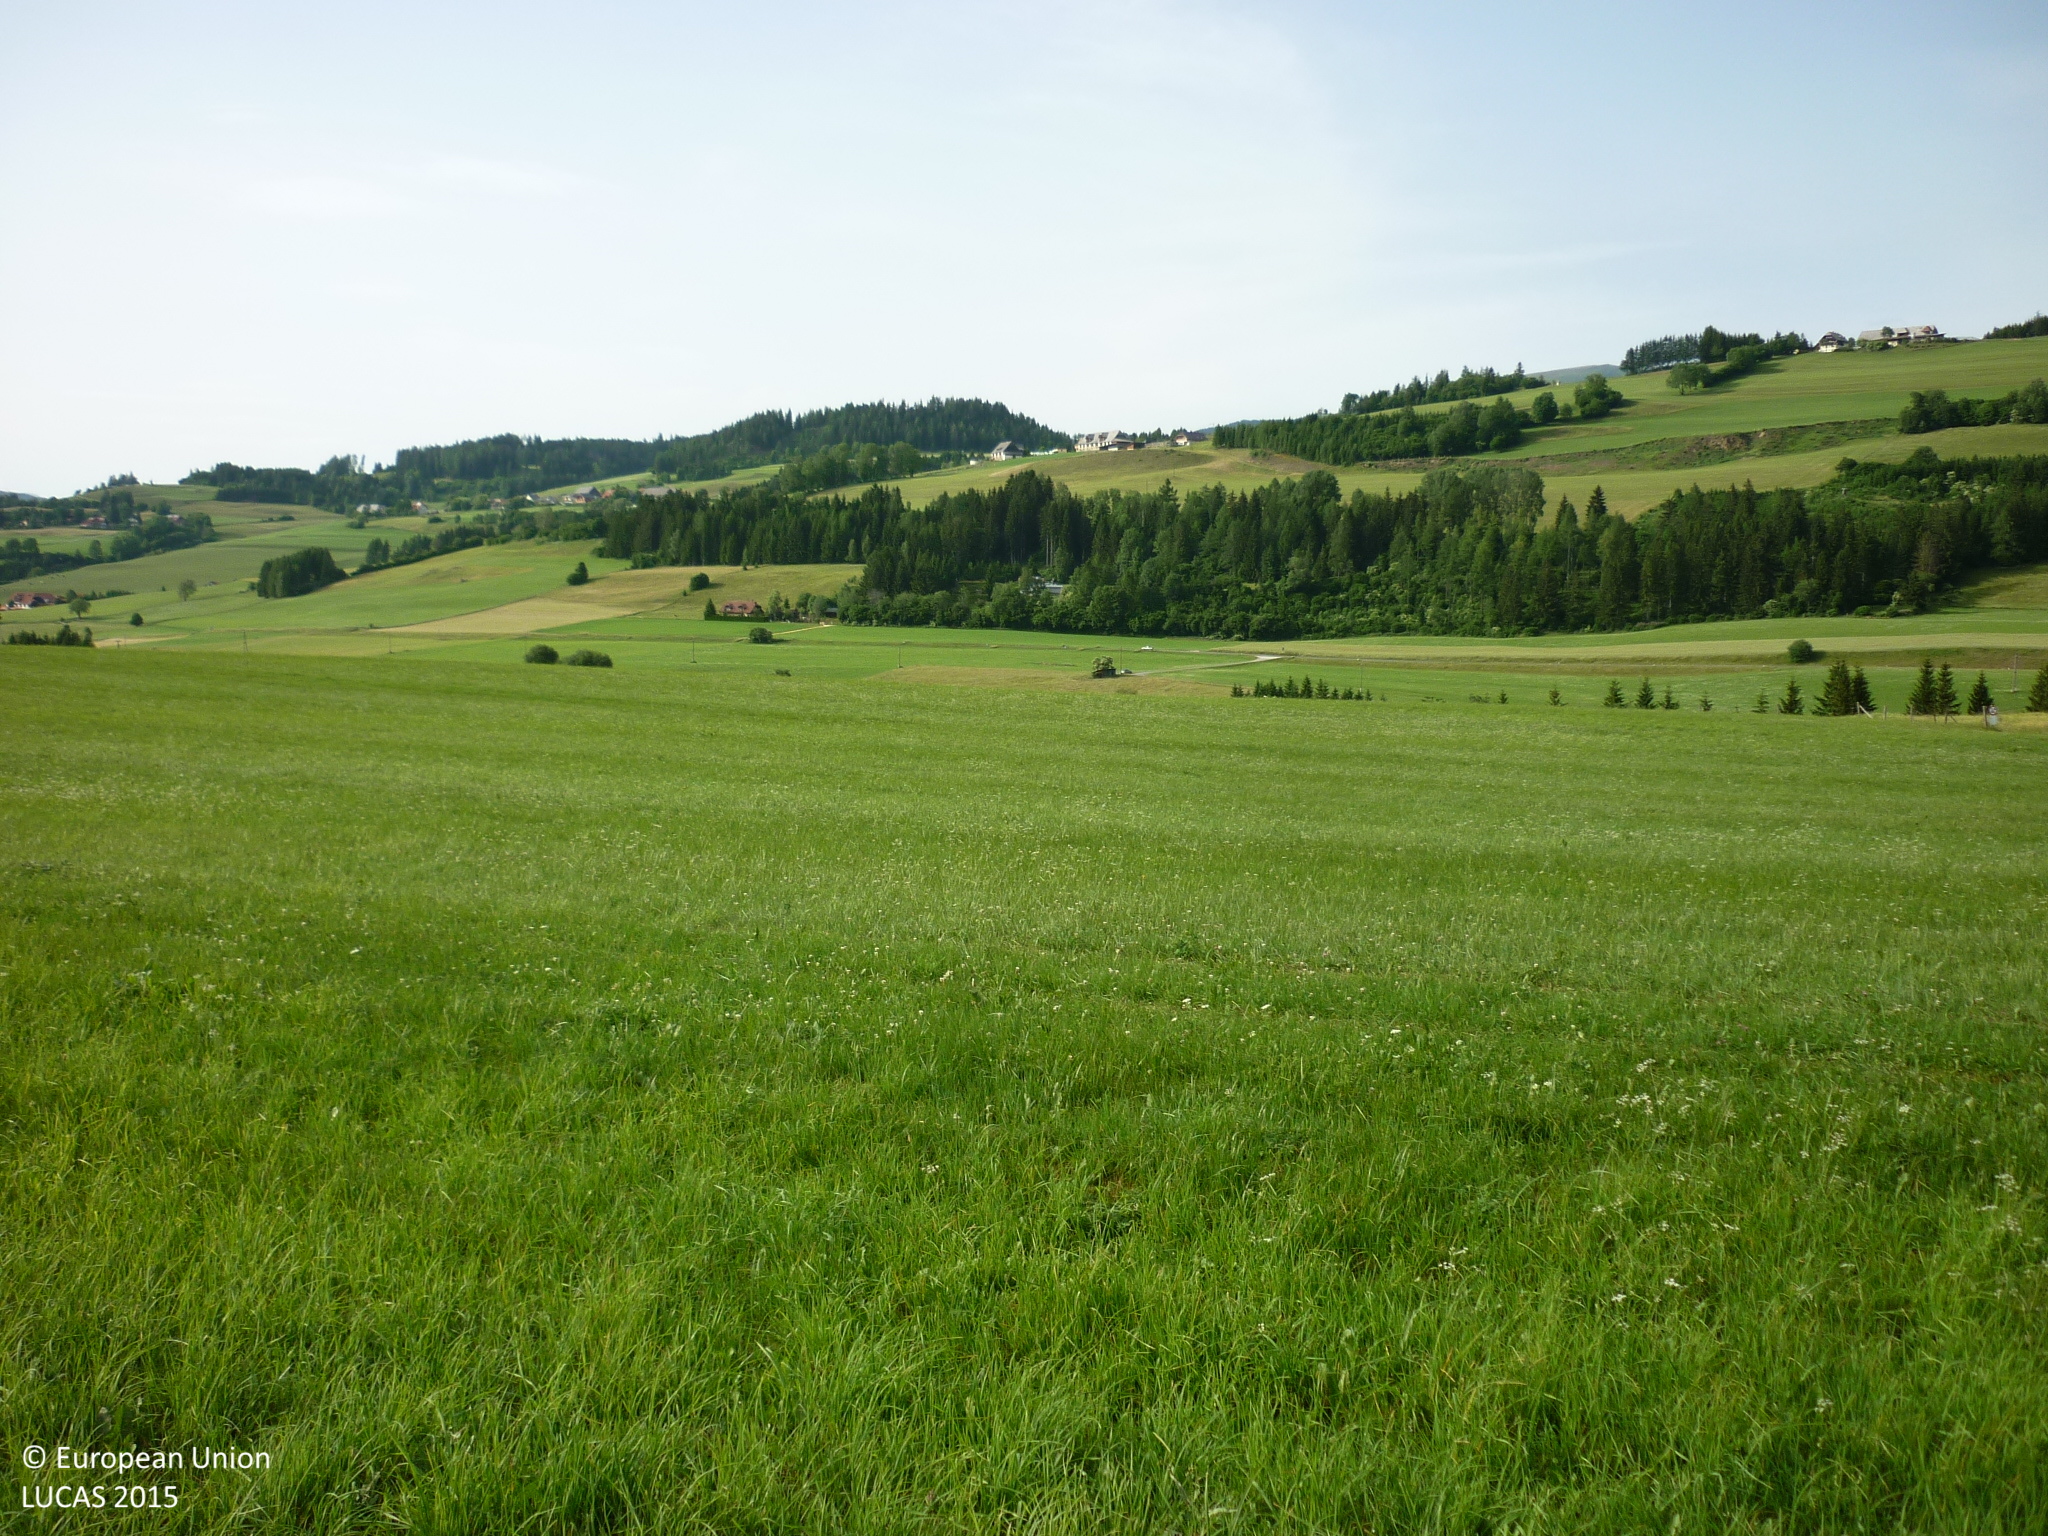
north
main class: Grassland
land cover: Grassland without tree/shrub cover
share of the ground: > 75 %
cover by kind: herbaceous plants 100 %
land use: Agriculture (excluding fallow land and kitchen gardens)
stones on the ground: < 10 %
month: June
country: AT
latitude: 47.0327
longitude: 14.4856
